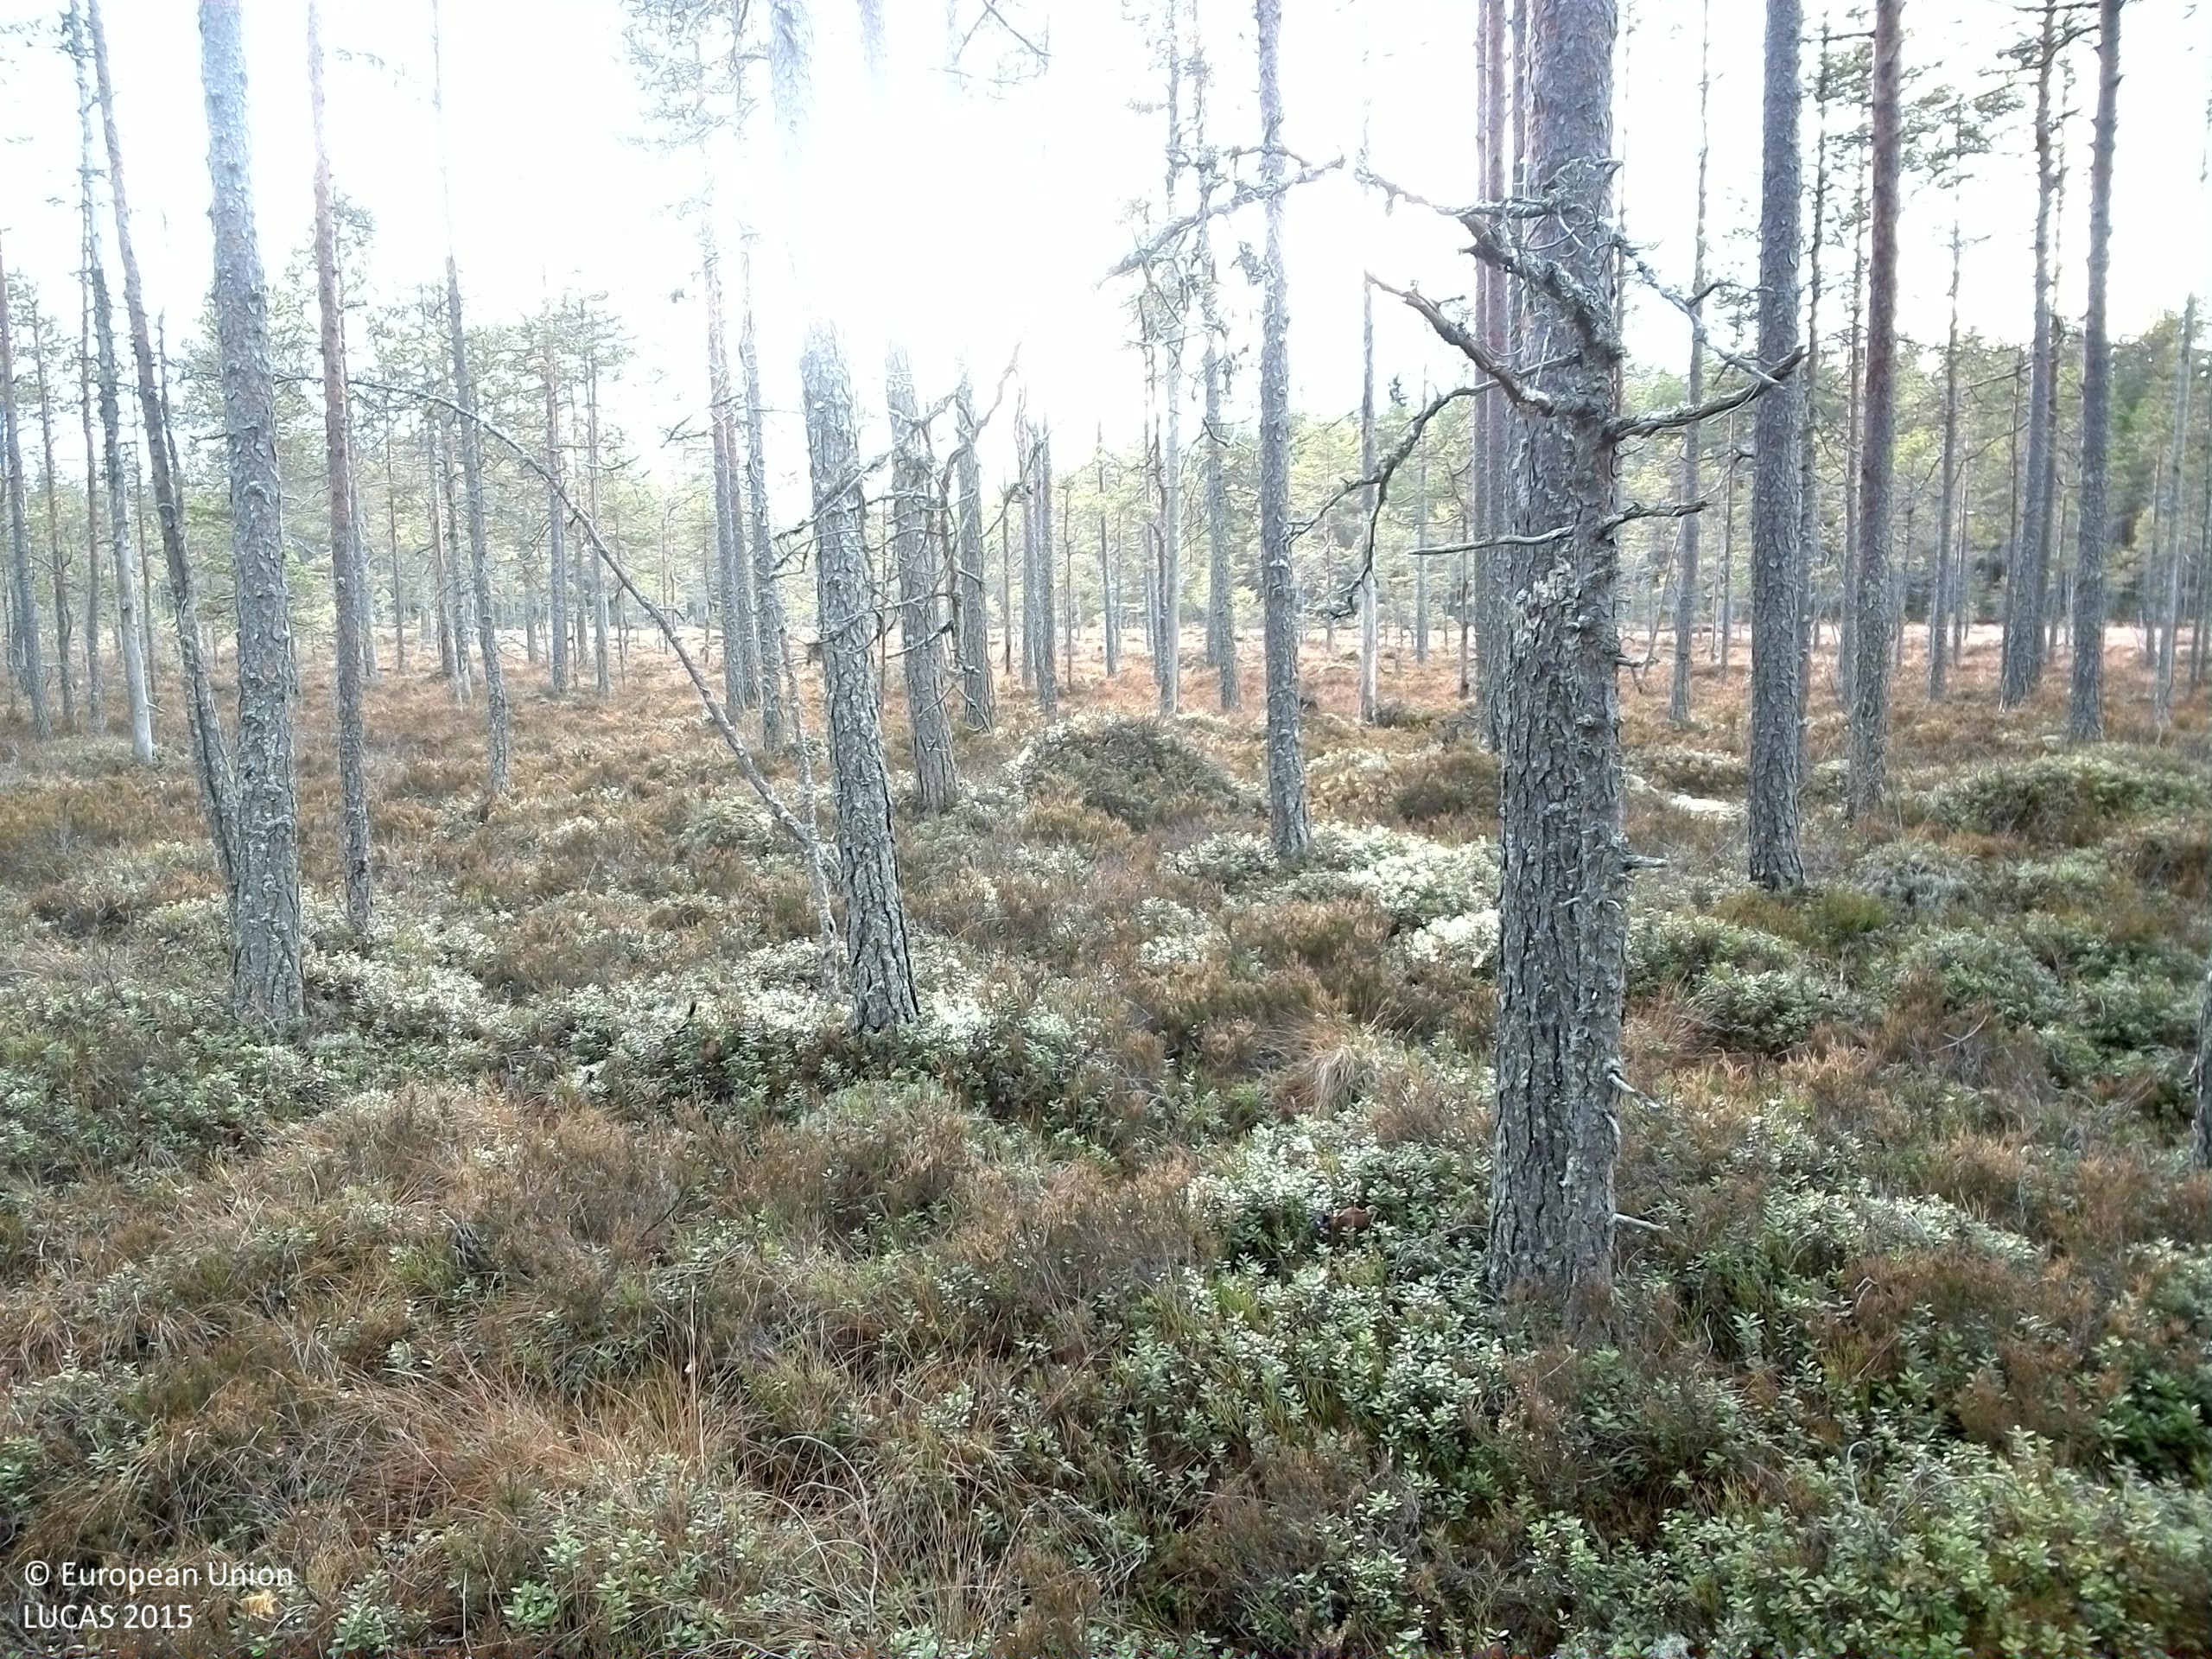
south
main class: Woodland
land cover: Pine dominated coniferous woodland
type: boreal forest
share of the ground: 50 - 75 %
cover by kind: coniferous forest trees 70 %, shrubs 25 %, lichens and mosses 5 %
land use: Forestry
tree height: > 5 m
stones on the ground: < 10 %
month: November
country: SE
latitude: 60.1951
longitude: 14.6243
